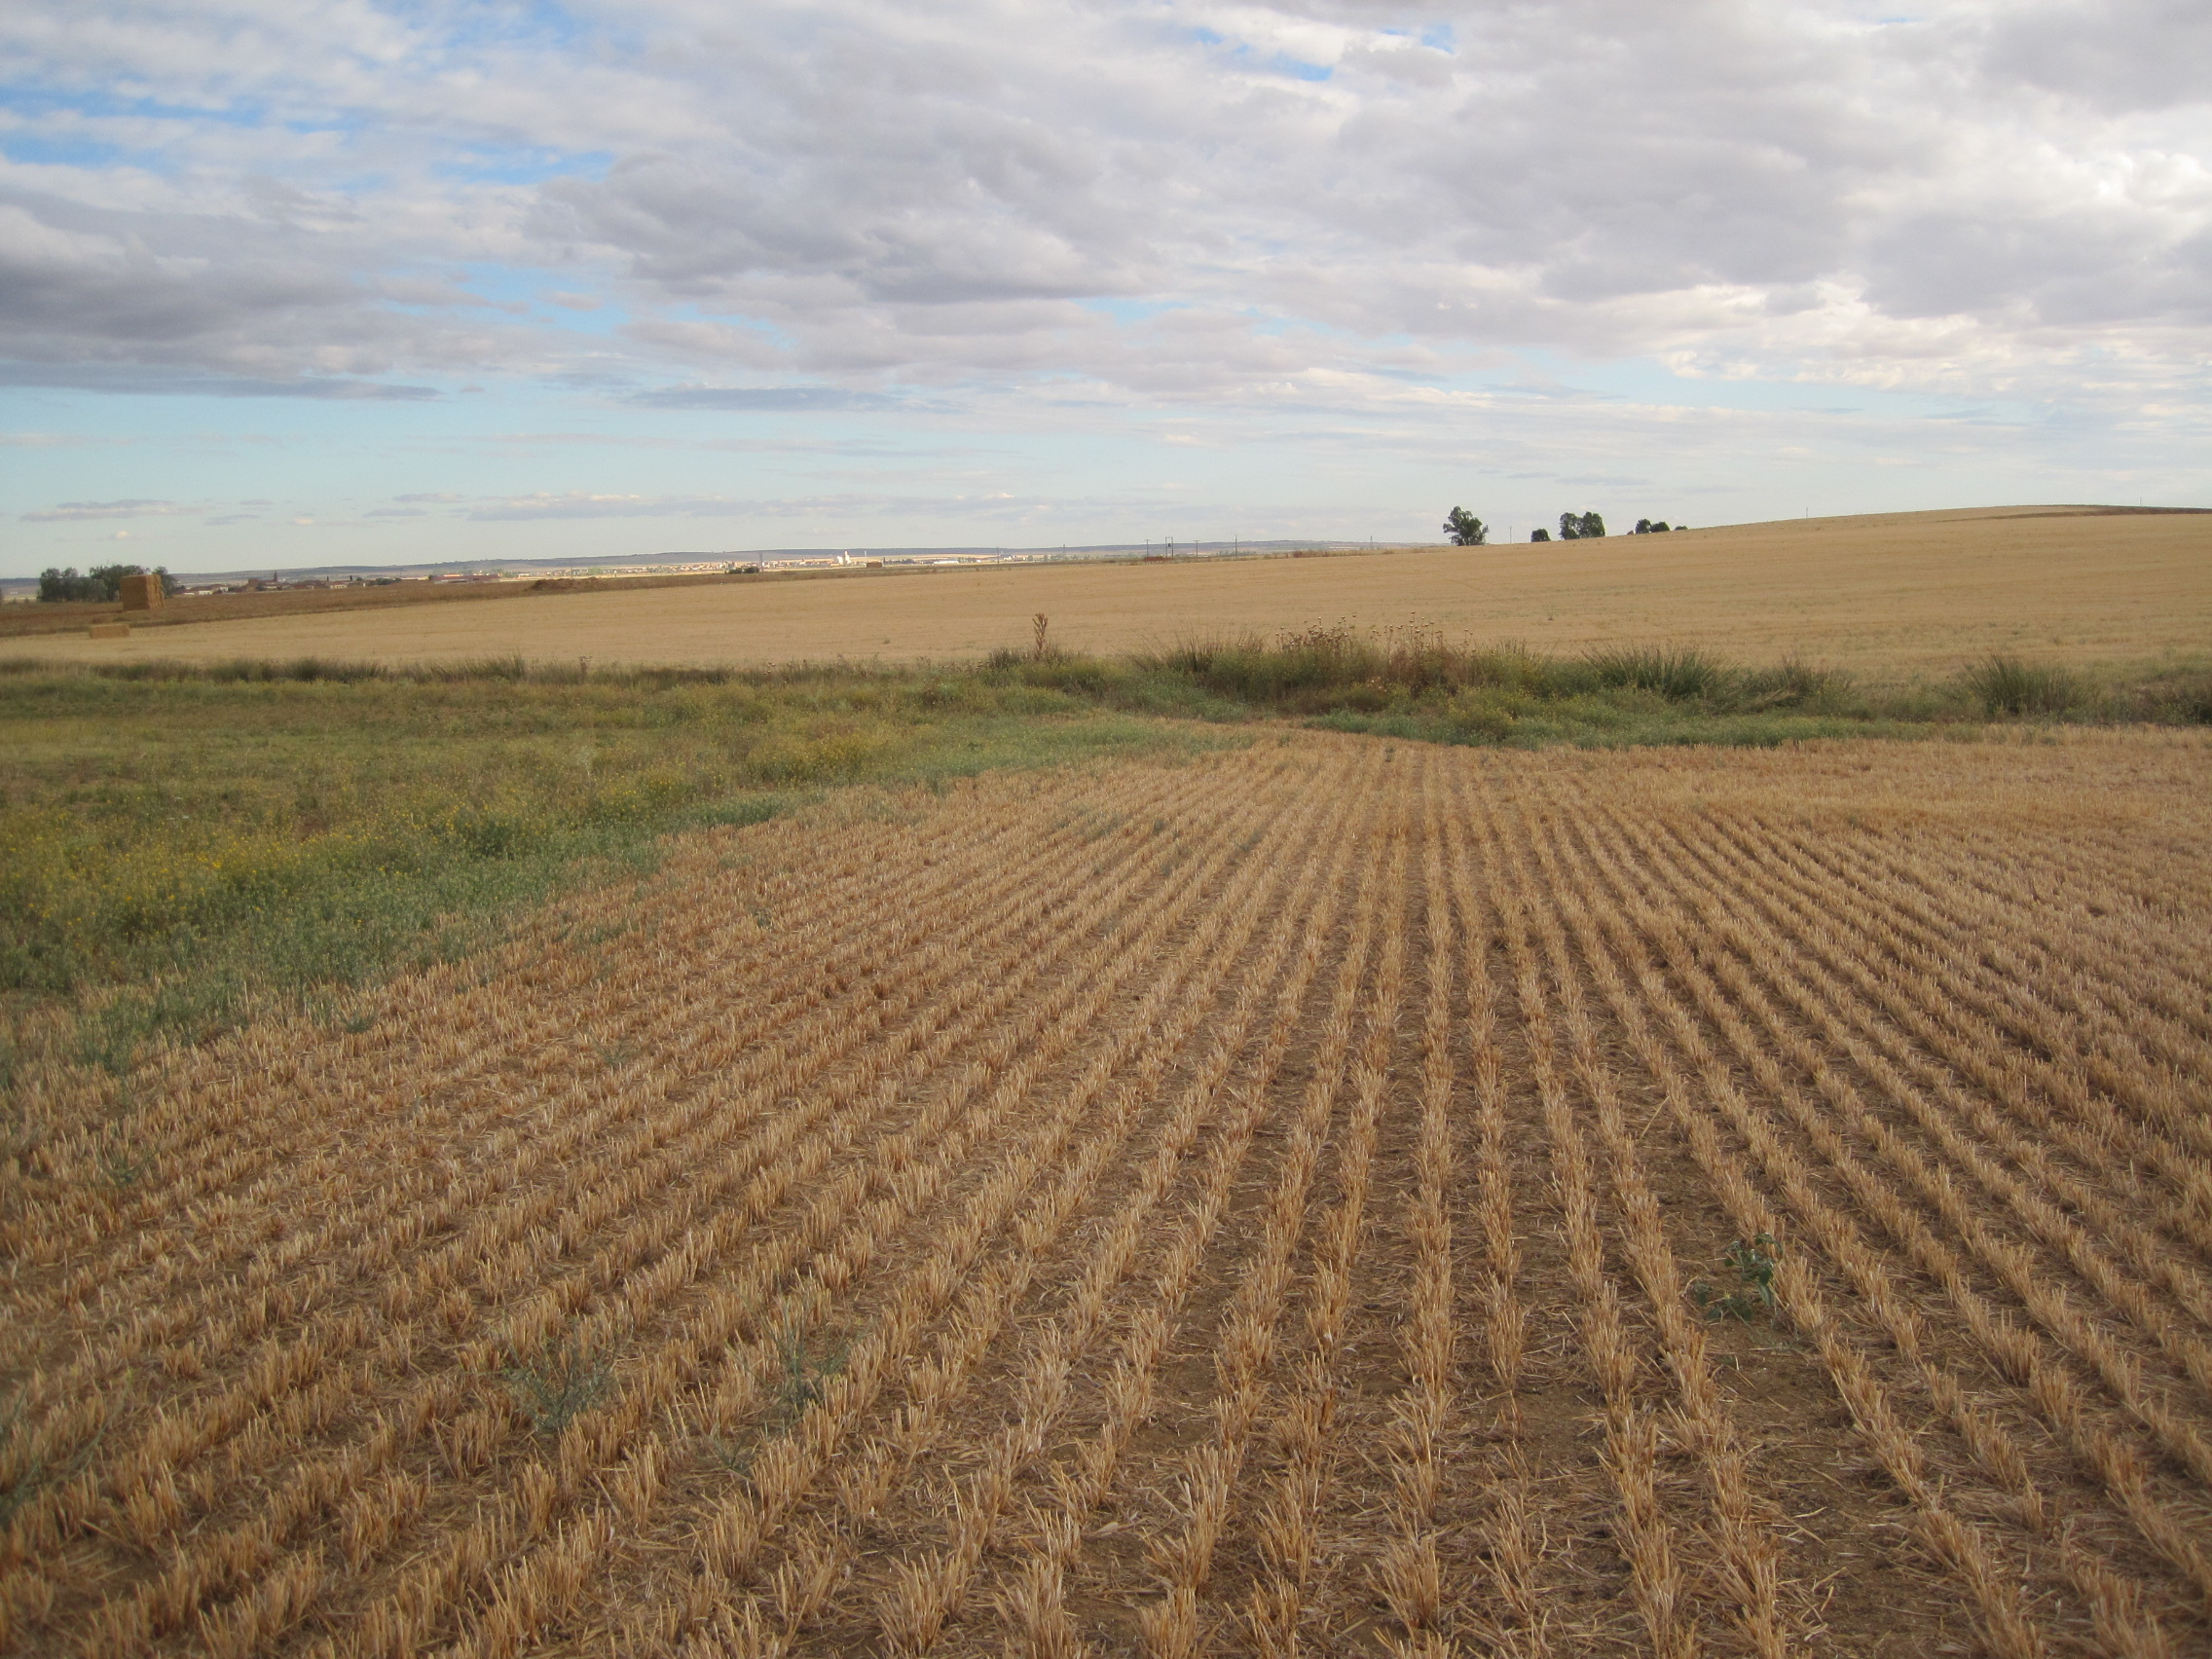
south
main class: Cropland
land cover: Barley
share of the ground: < 10 %
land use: Agriculture (excluding fallow land and kitchen gardens)
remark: Harvested field
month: July
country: ES
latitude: 41.9251
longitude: -5.4119
